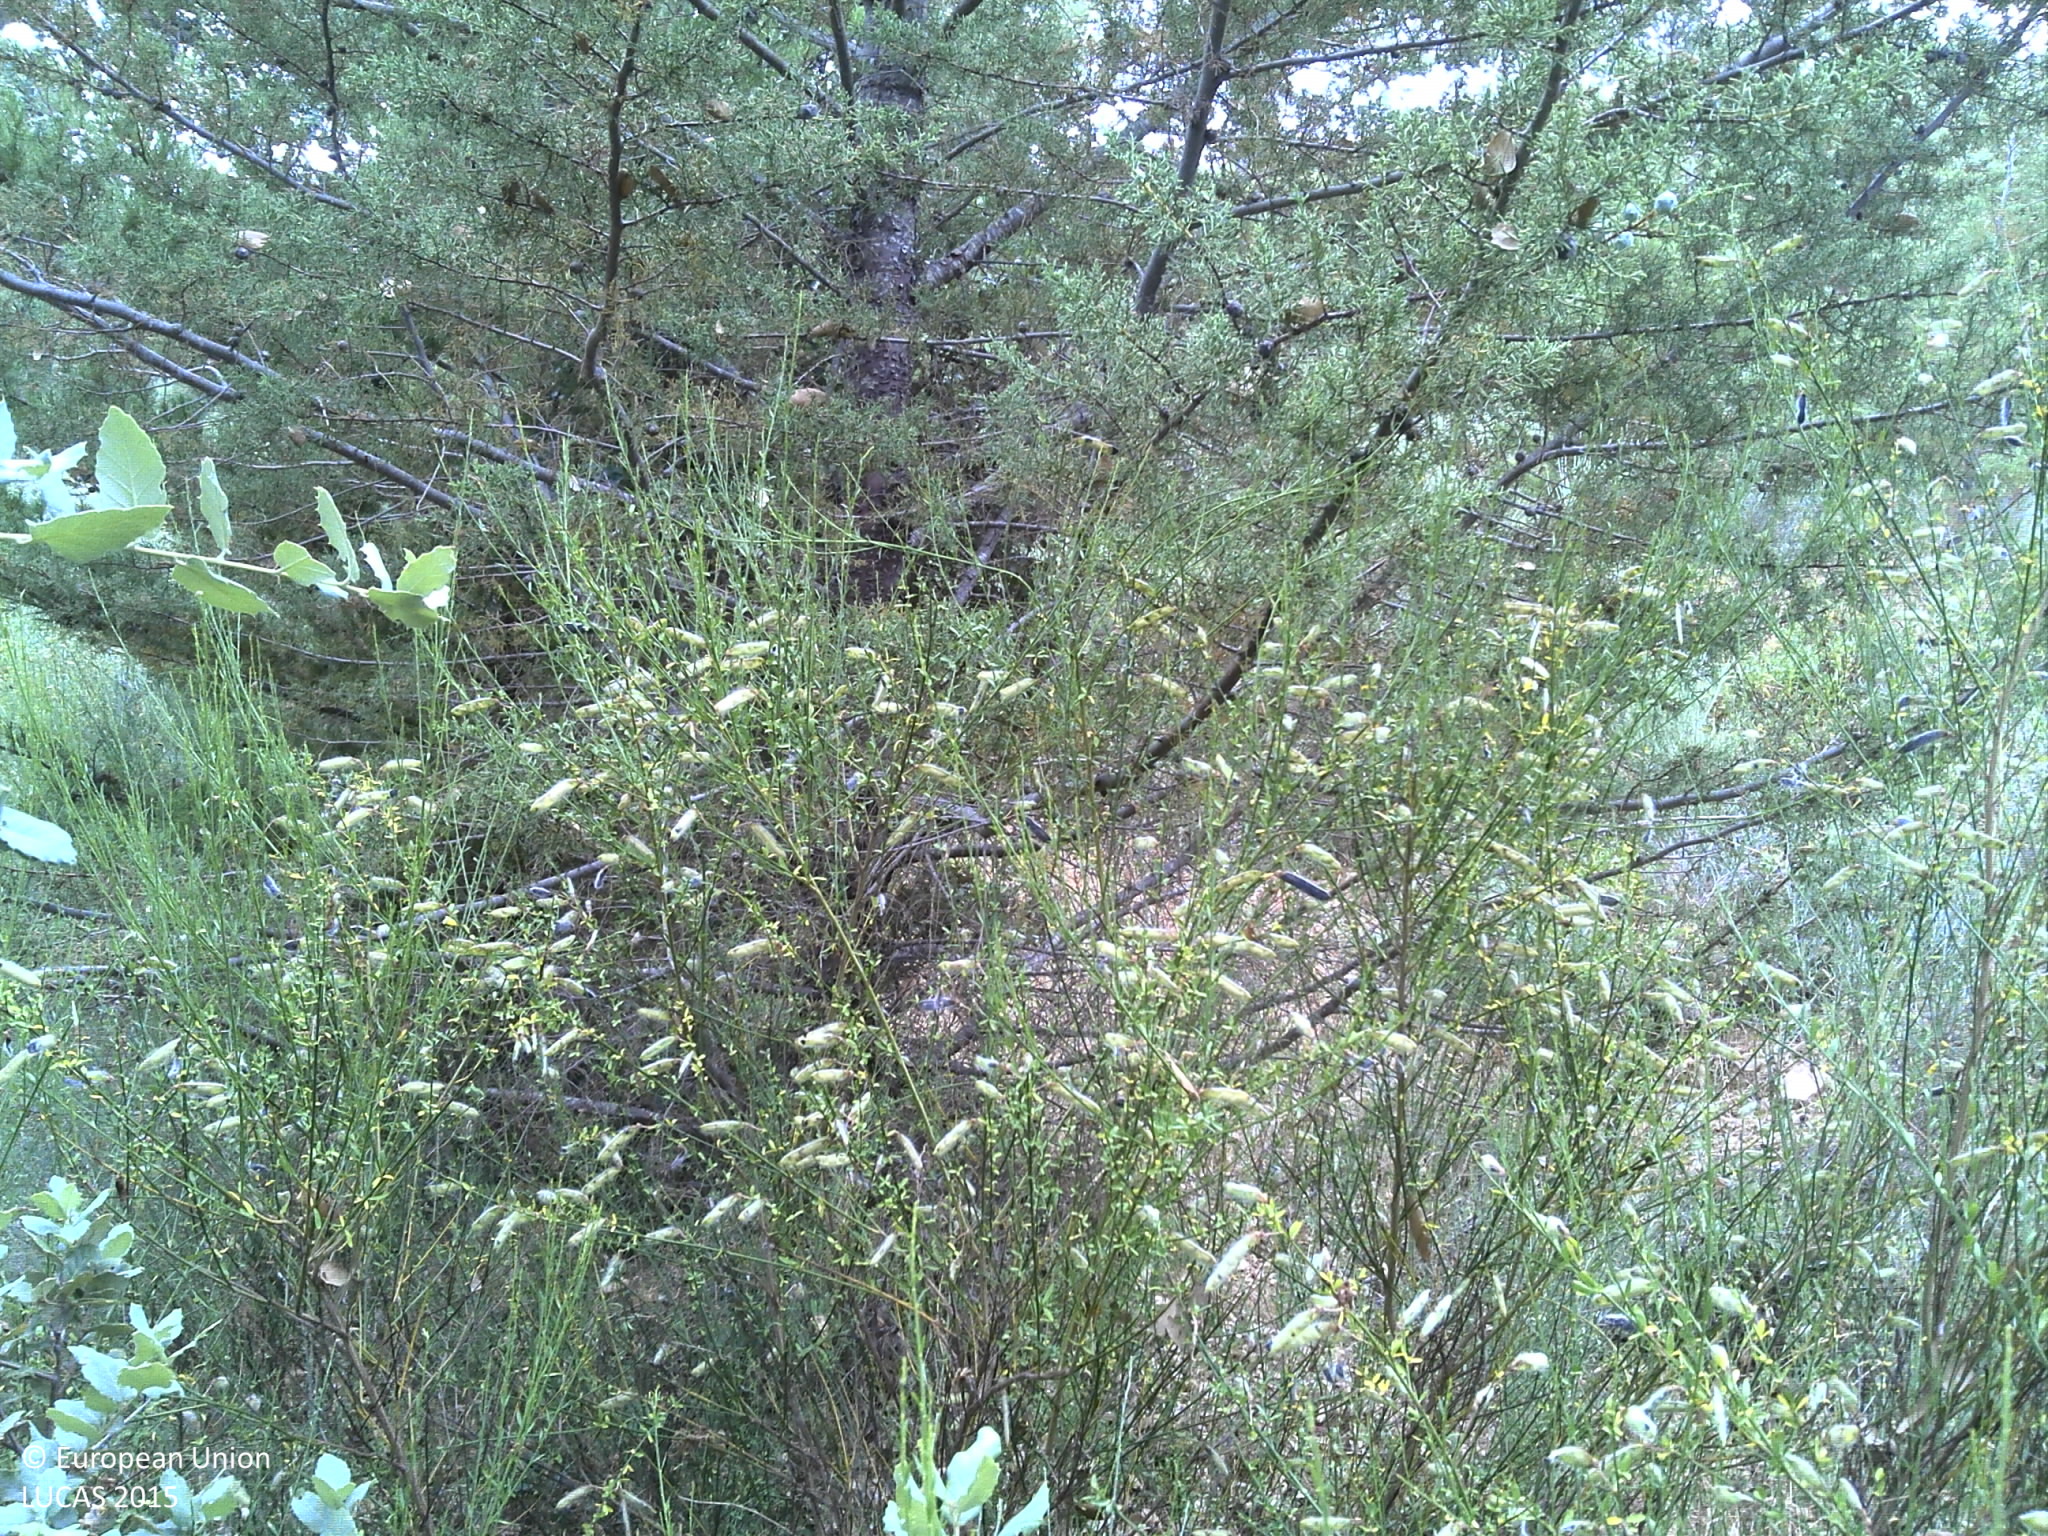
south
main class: Woodland
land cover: Other coniferous woodland
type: coniferous forest of the mediterranean region
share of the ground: < 10 %
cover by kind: shrubs 45 %, herbaceous plants 45 %, coniferous forest trees 10 %
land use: Forestry
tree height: > 5 m
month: June
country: PT
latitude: 41.2990
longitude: -6.9861
